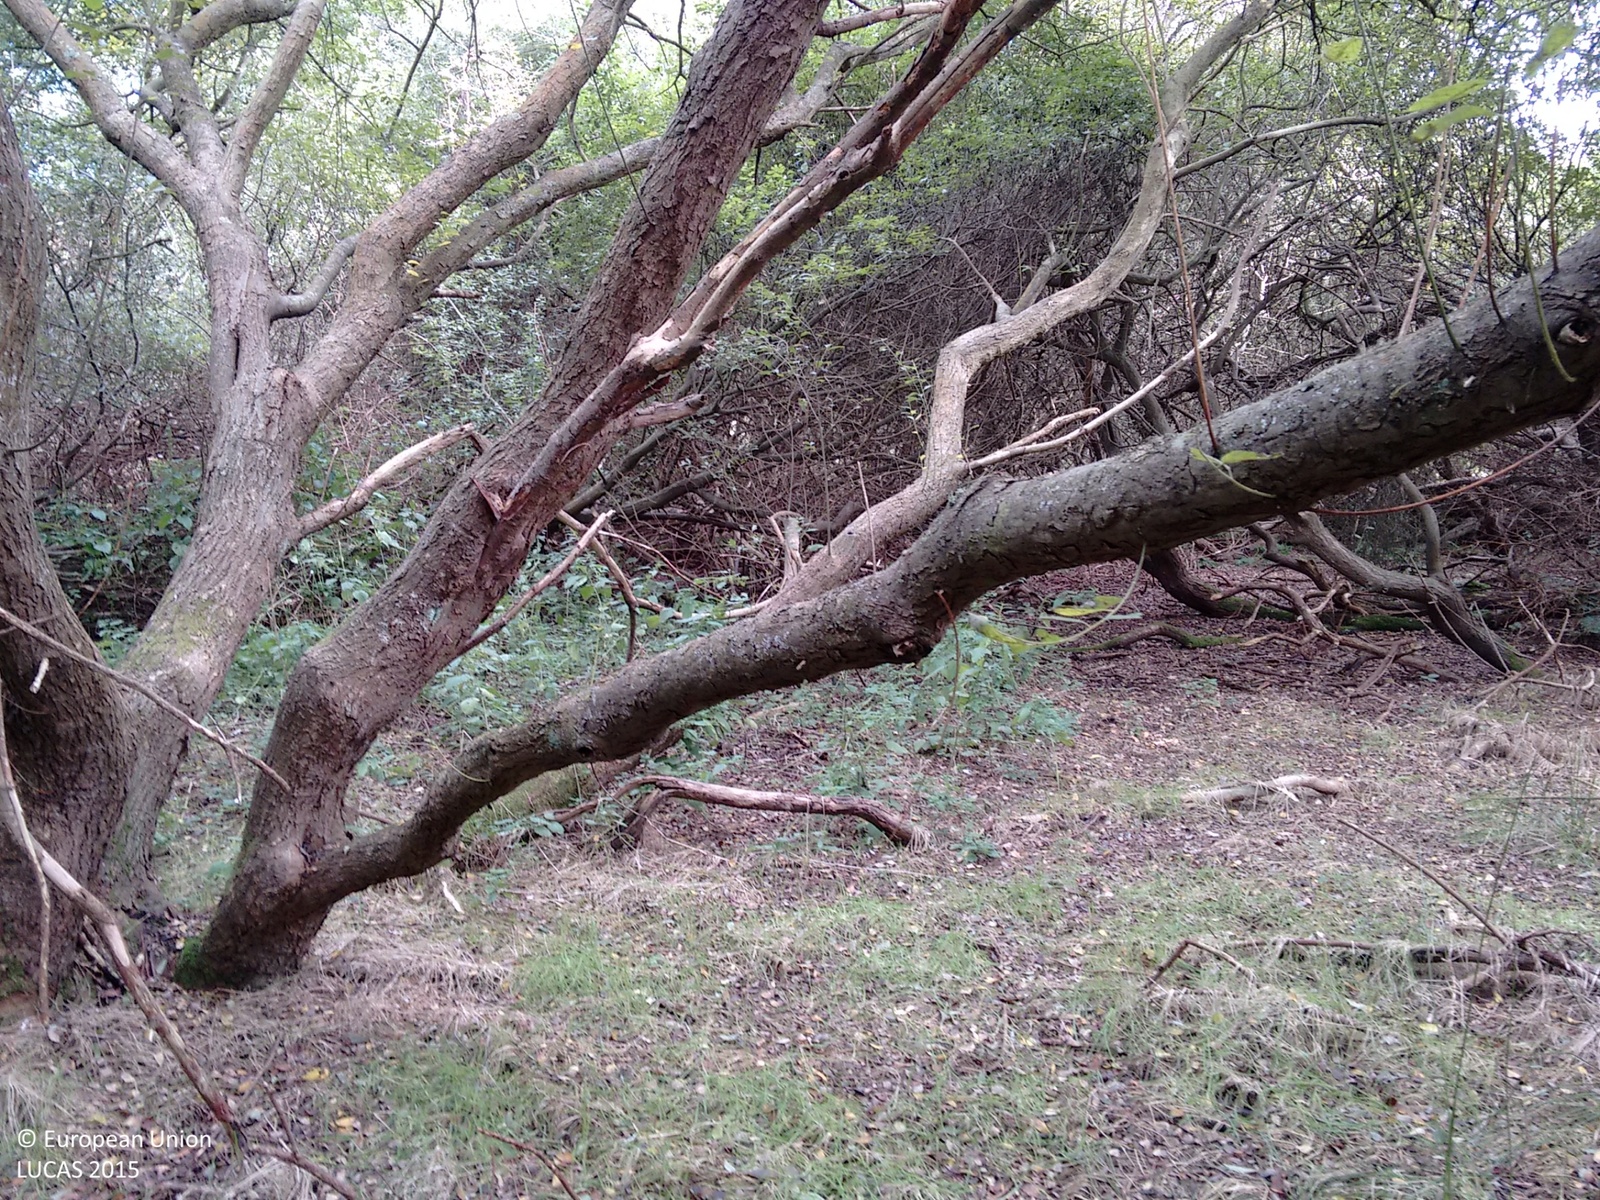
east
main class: Woodland
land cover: Other mixed woodland
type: mesophytic deciduous forest
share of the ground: > 75 %
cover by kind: broadleaved forest trees 75 %, coniferous forest trees 25 %
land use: Forestry
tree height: > 5 m
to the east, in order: Other mixed woodland; Grass margins; Tracks; Grass margins; Fences; Other mixed woodland
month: September
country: GB
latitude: 52.7353
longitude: 1.6739
